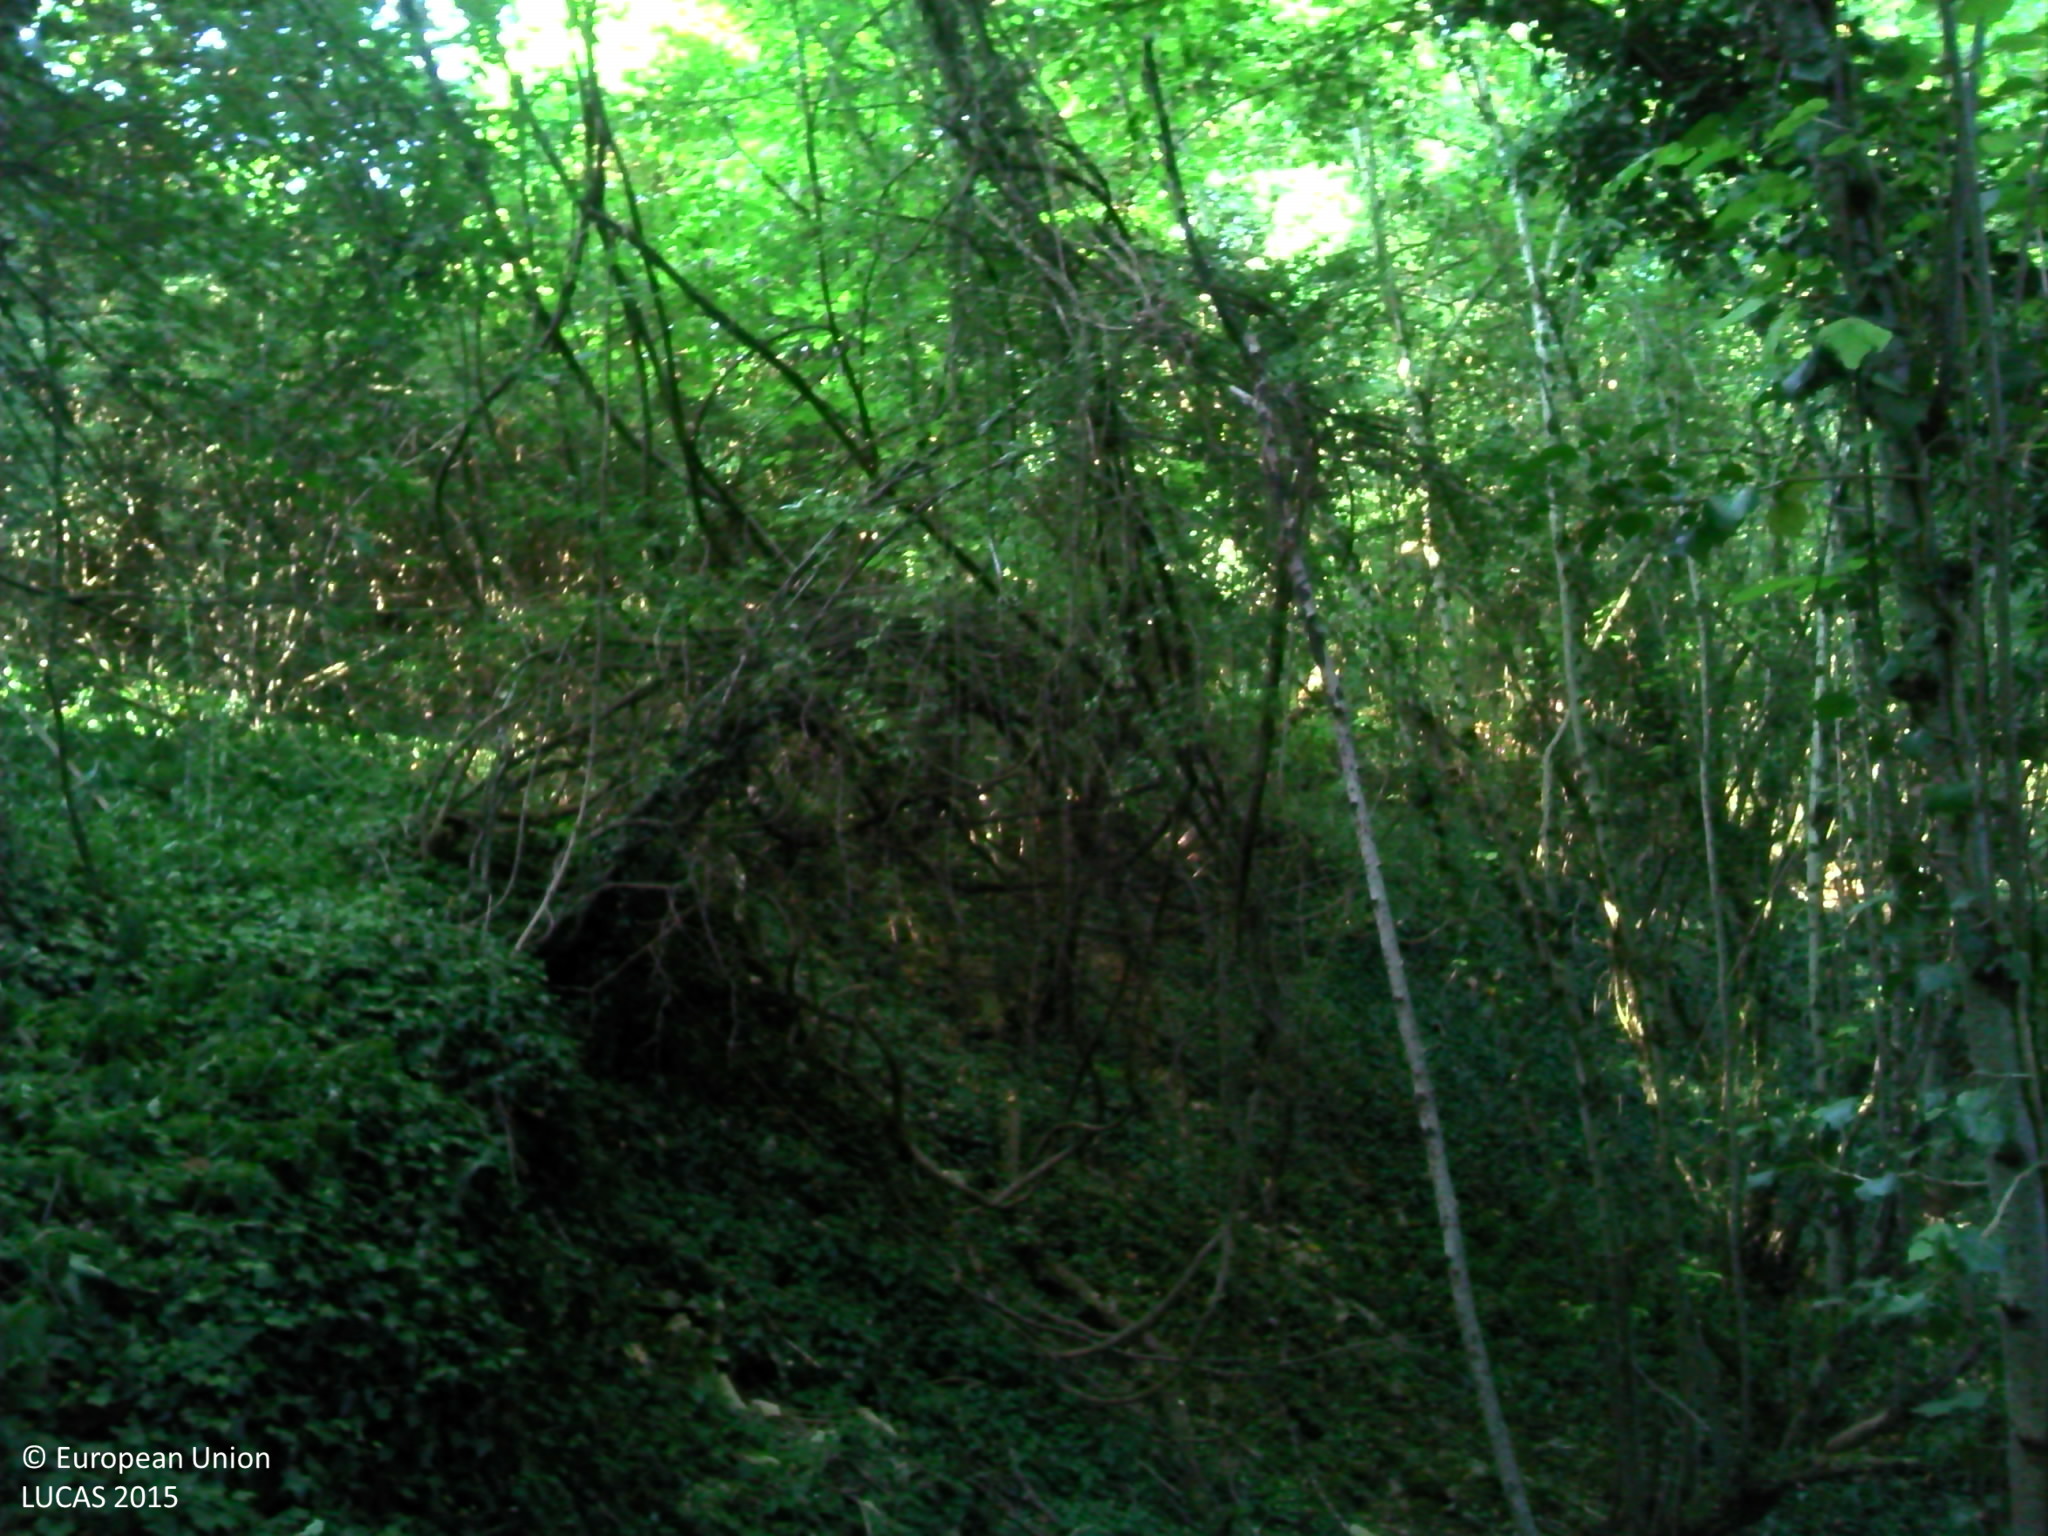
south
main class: Woodland
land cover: Broadleaved woodland
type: mesophytic deciduous forest
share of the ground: > 75 %
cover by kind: broadleaved forest trees 100 %
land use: Semi-natural and natural areas not in use
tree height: > 5 m
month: July
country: FR
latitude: 46.8439
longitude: 3.2701
